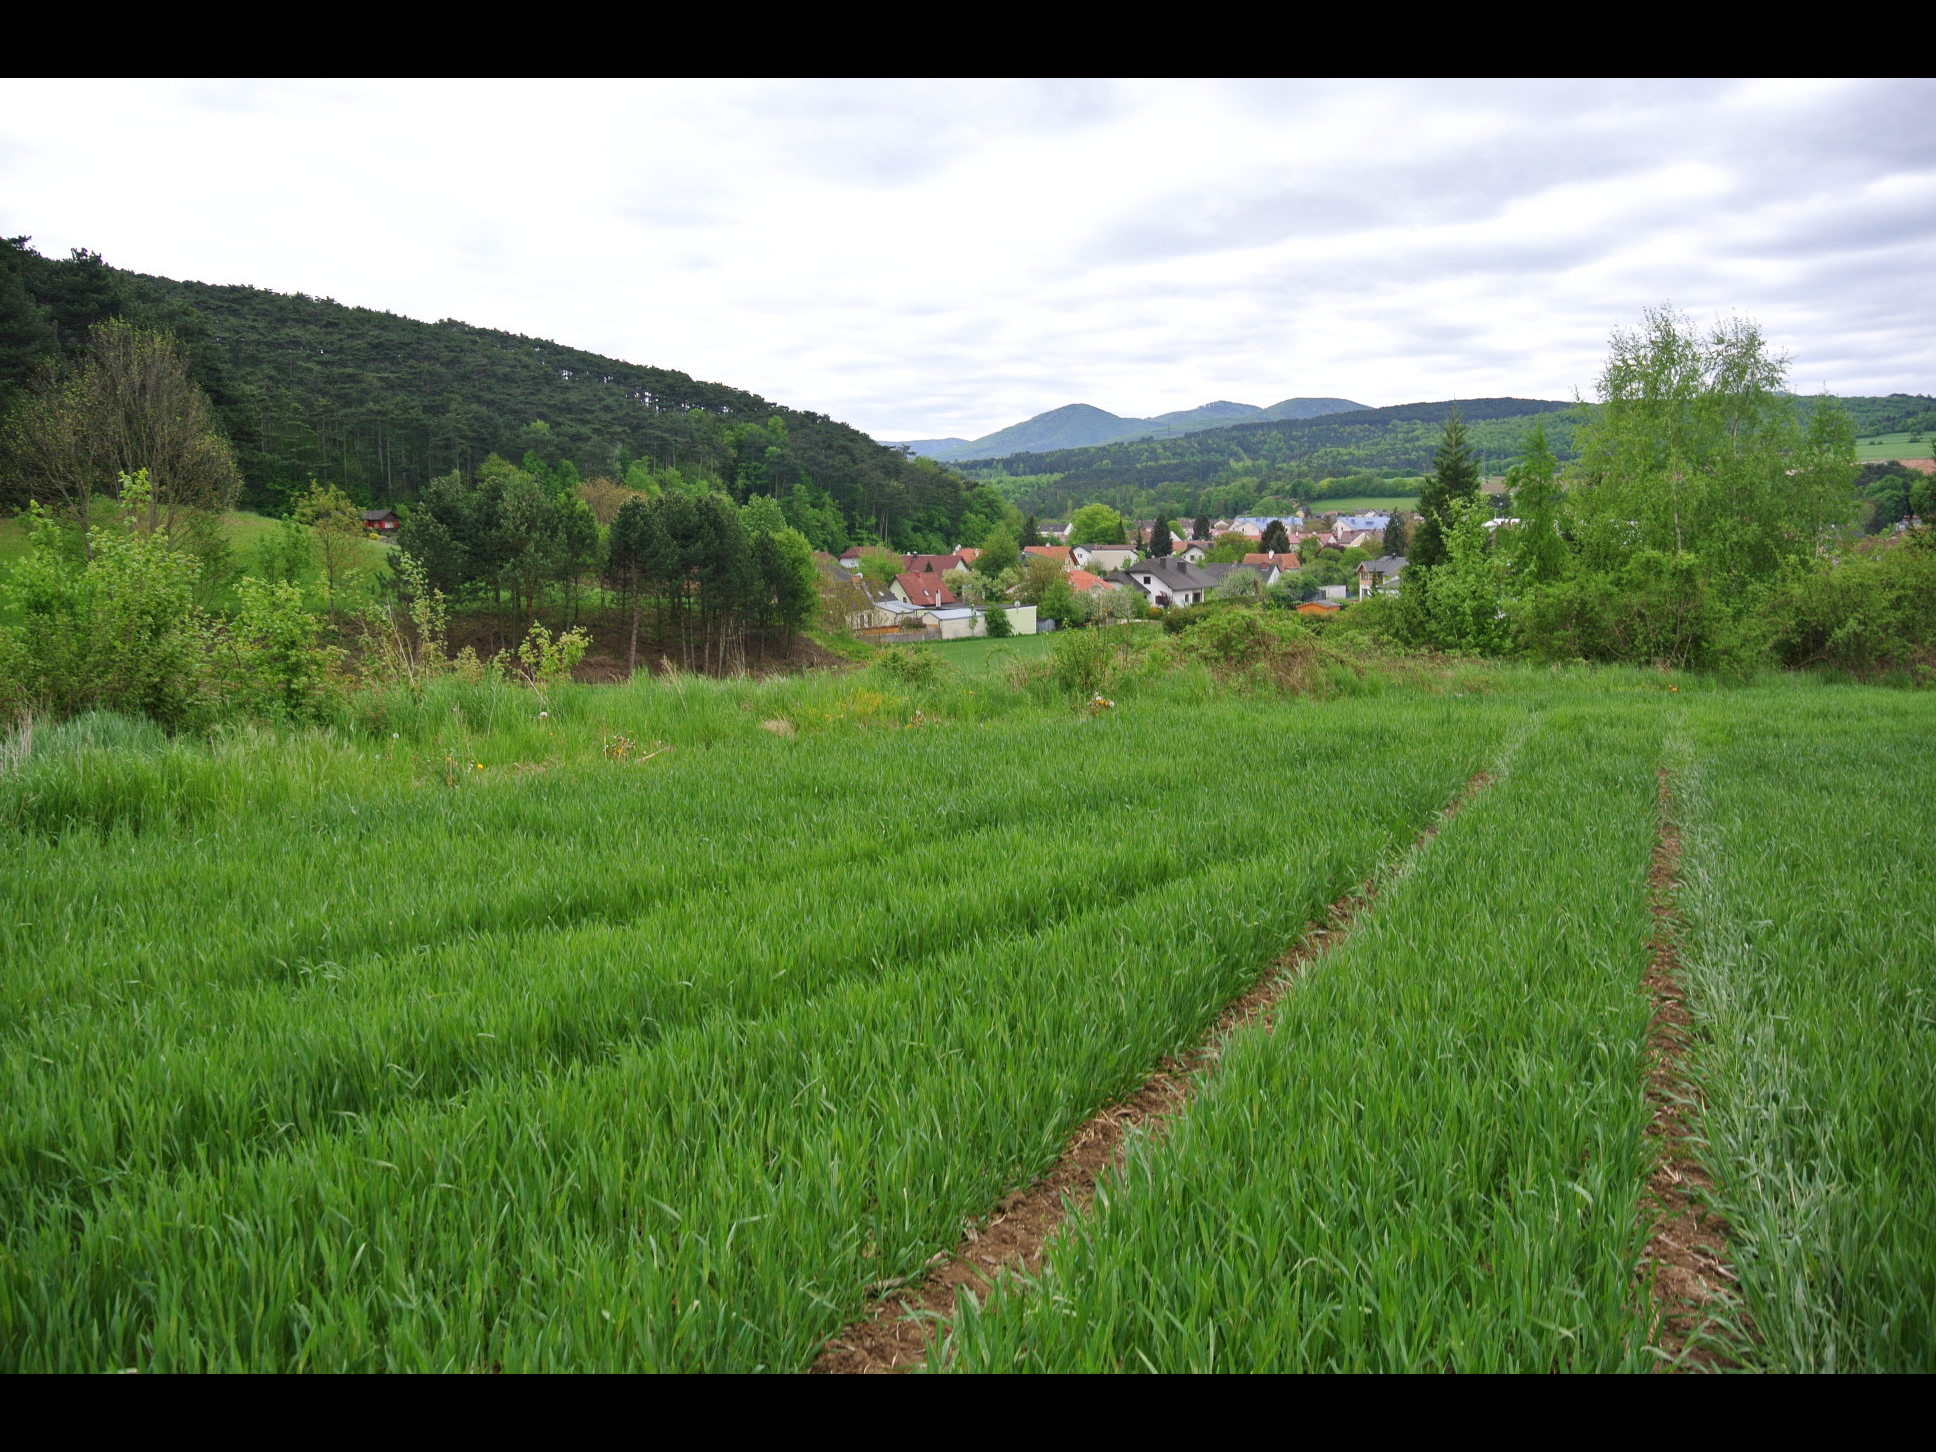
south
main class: Cropland
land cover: Barley
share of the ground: > 75 %
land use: Agriculture (excluding fallow land and kitchen gardens)
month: May
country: AT
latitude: 47.9645
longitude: 16.0976
